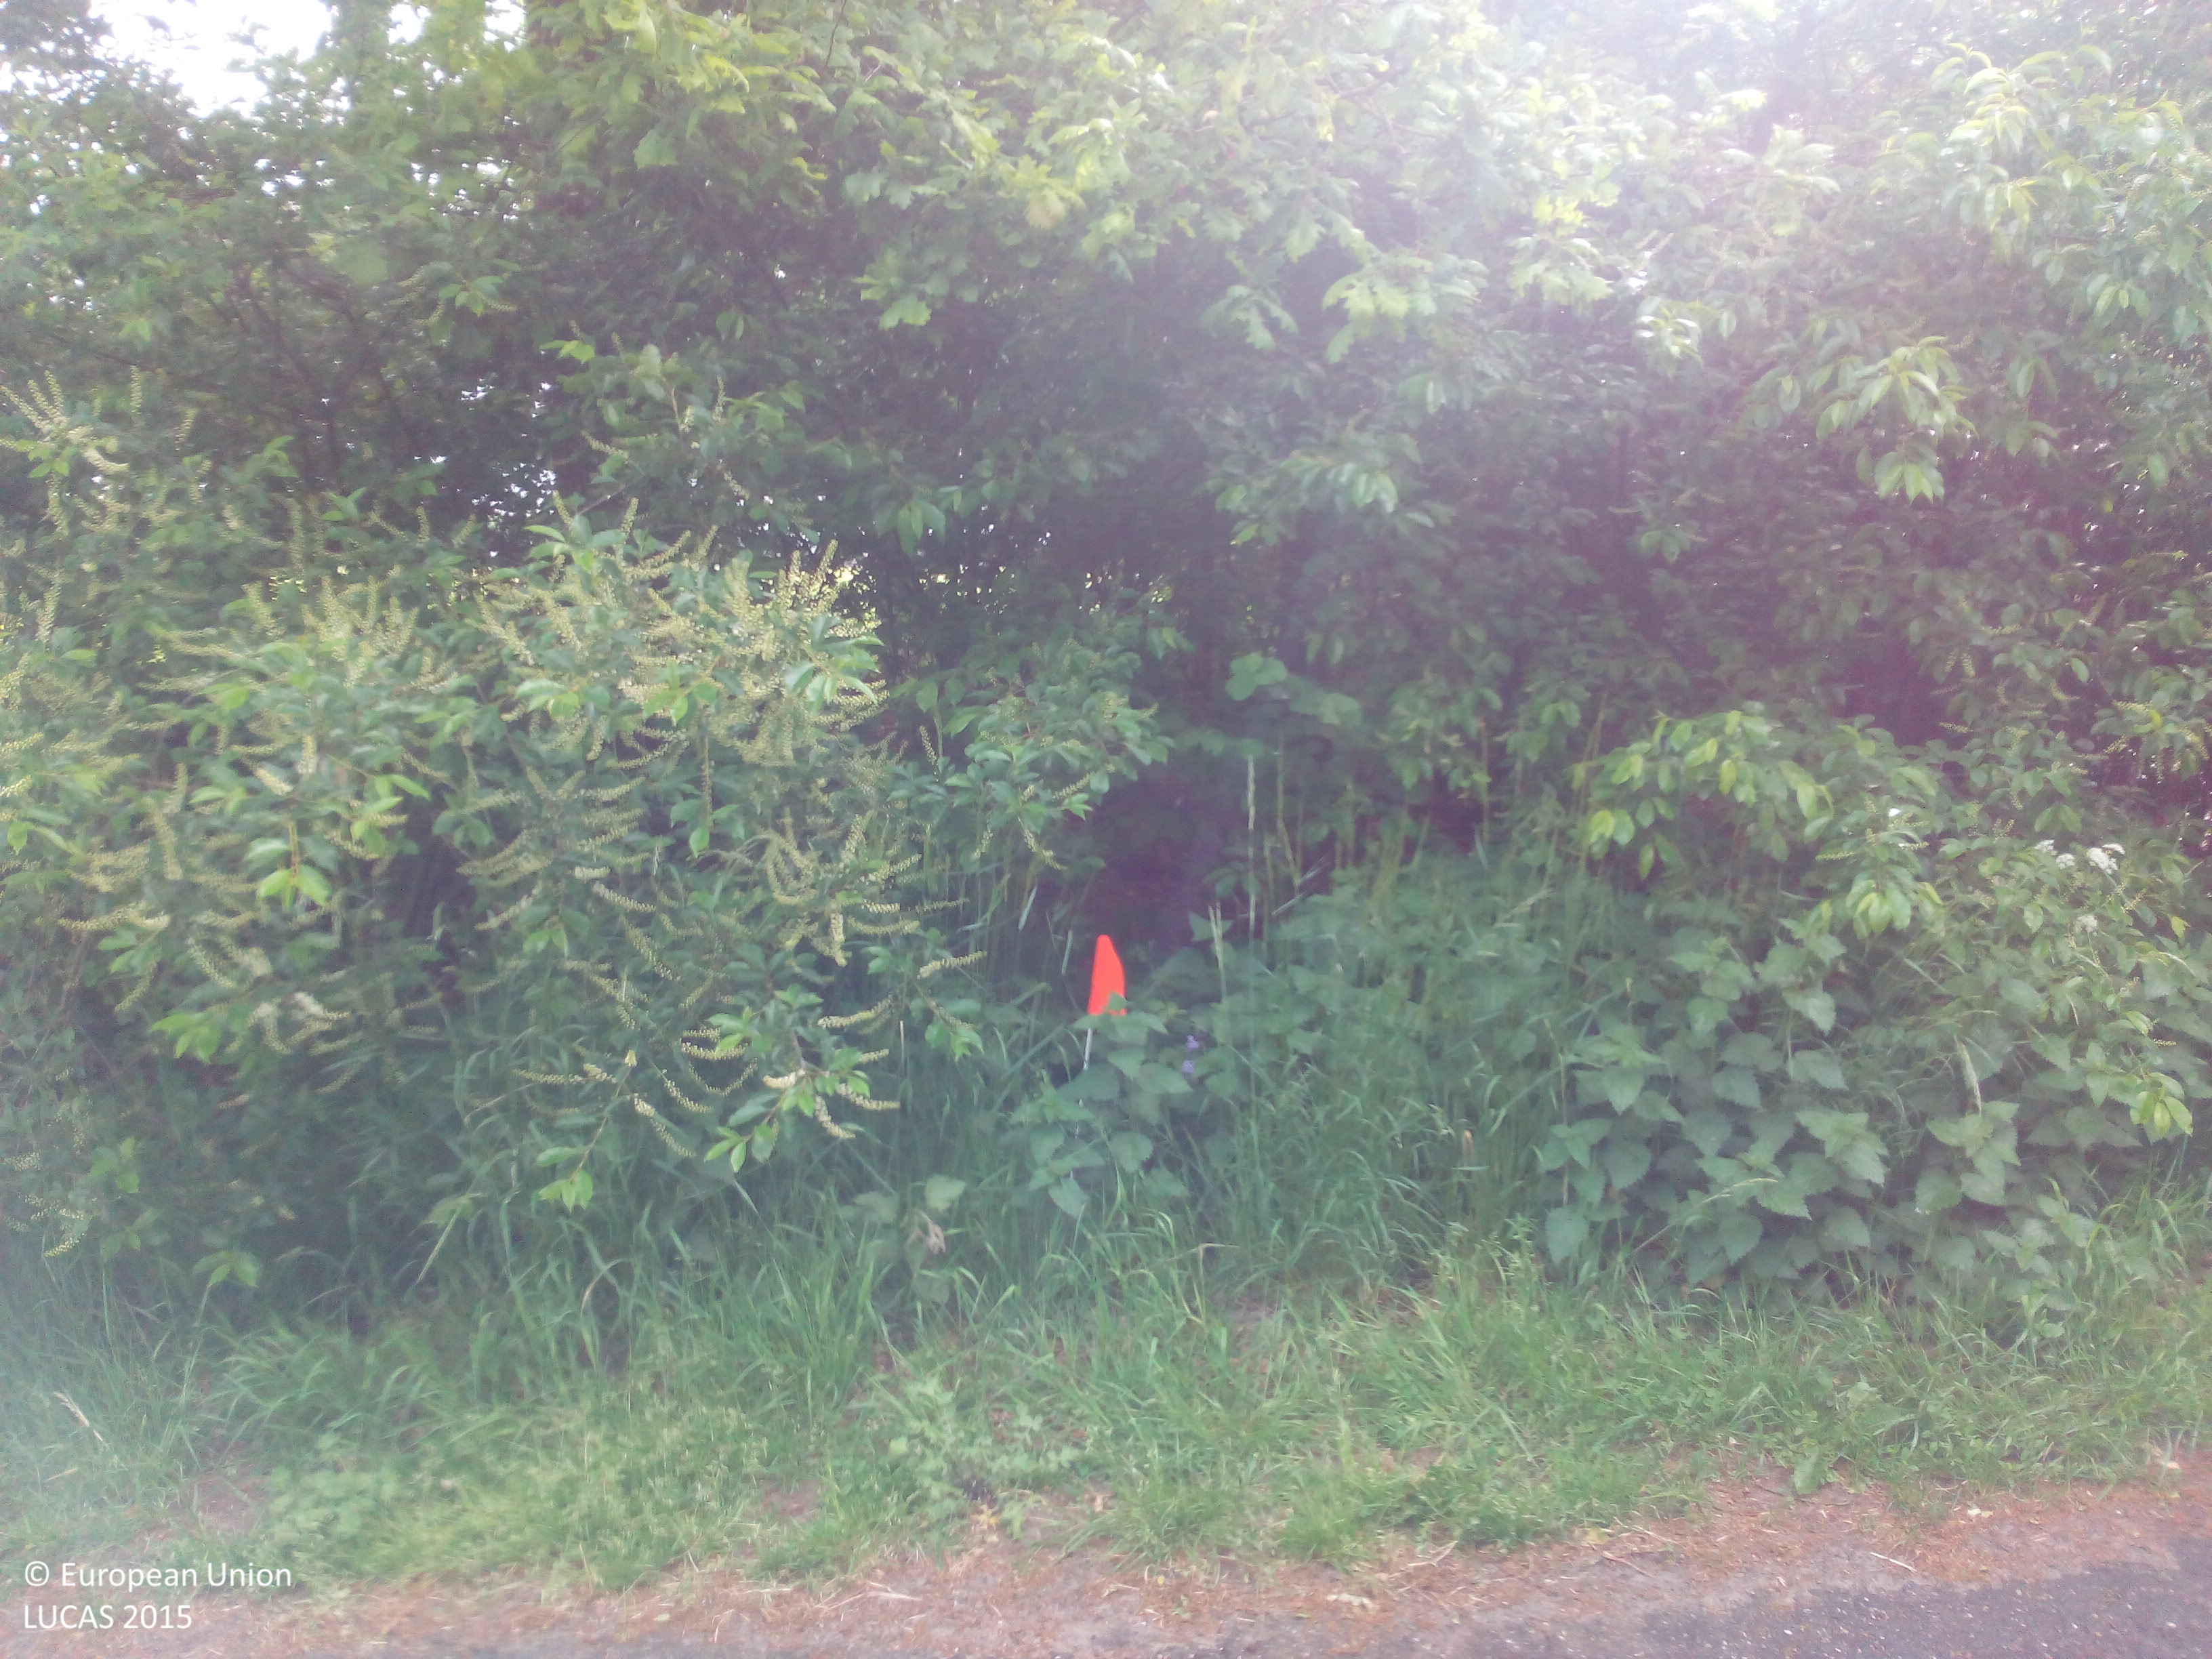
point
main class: Woodland
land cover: Broadleaved woodland
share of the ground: > 75 %
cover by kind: broadleaved forest trees 90 %, shrubs 10 %
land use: Road transport
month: May
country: NL
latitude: 52.2827
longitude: 6.2616
